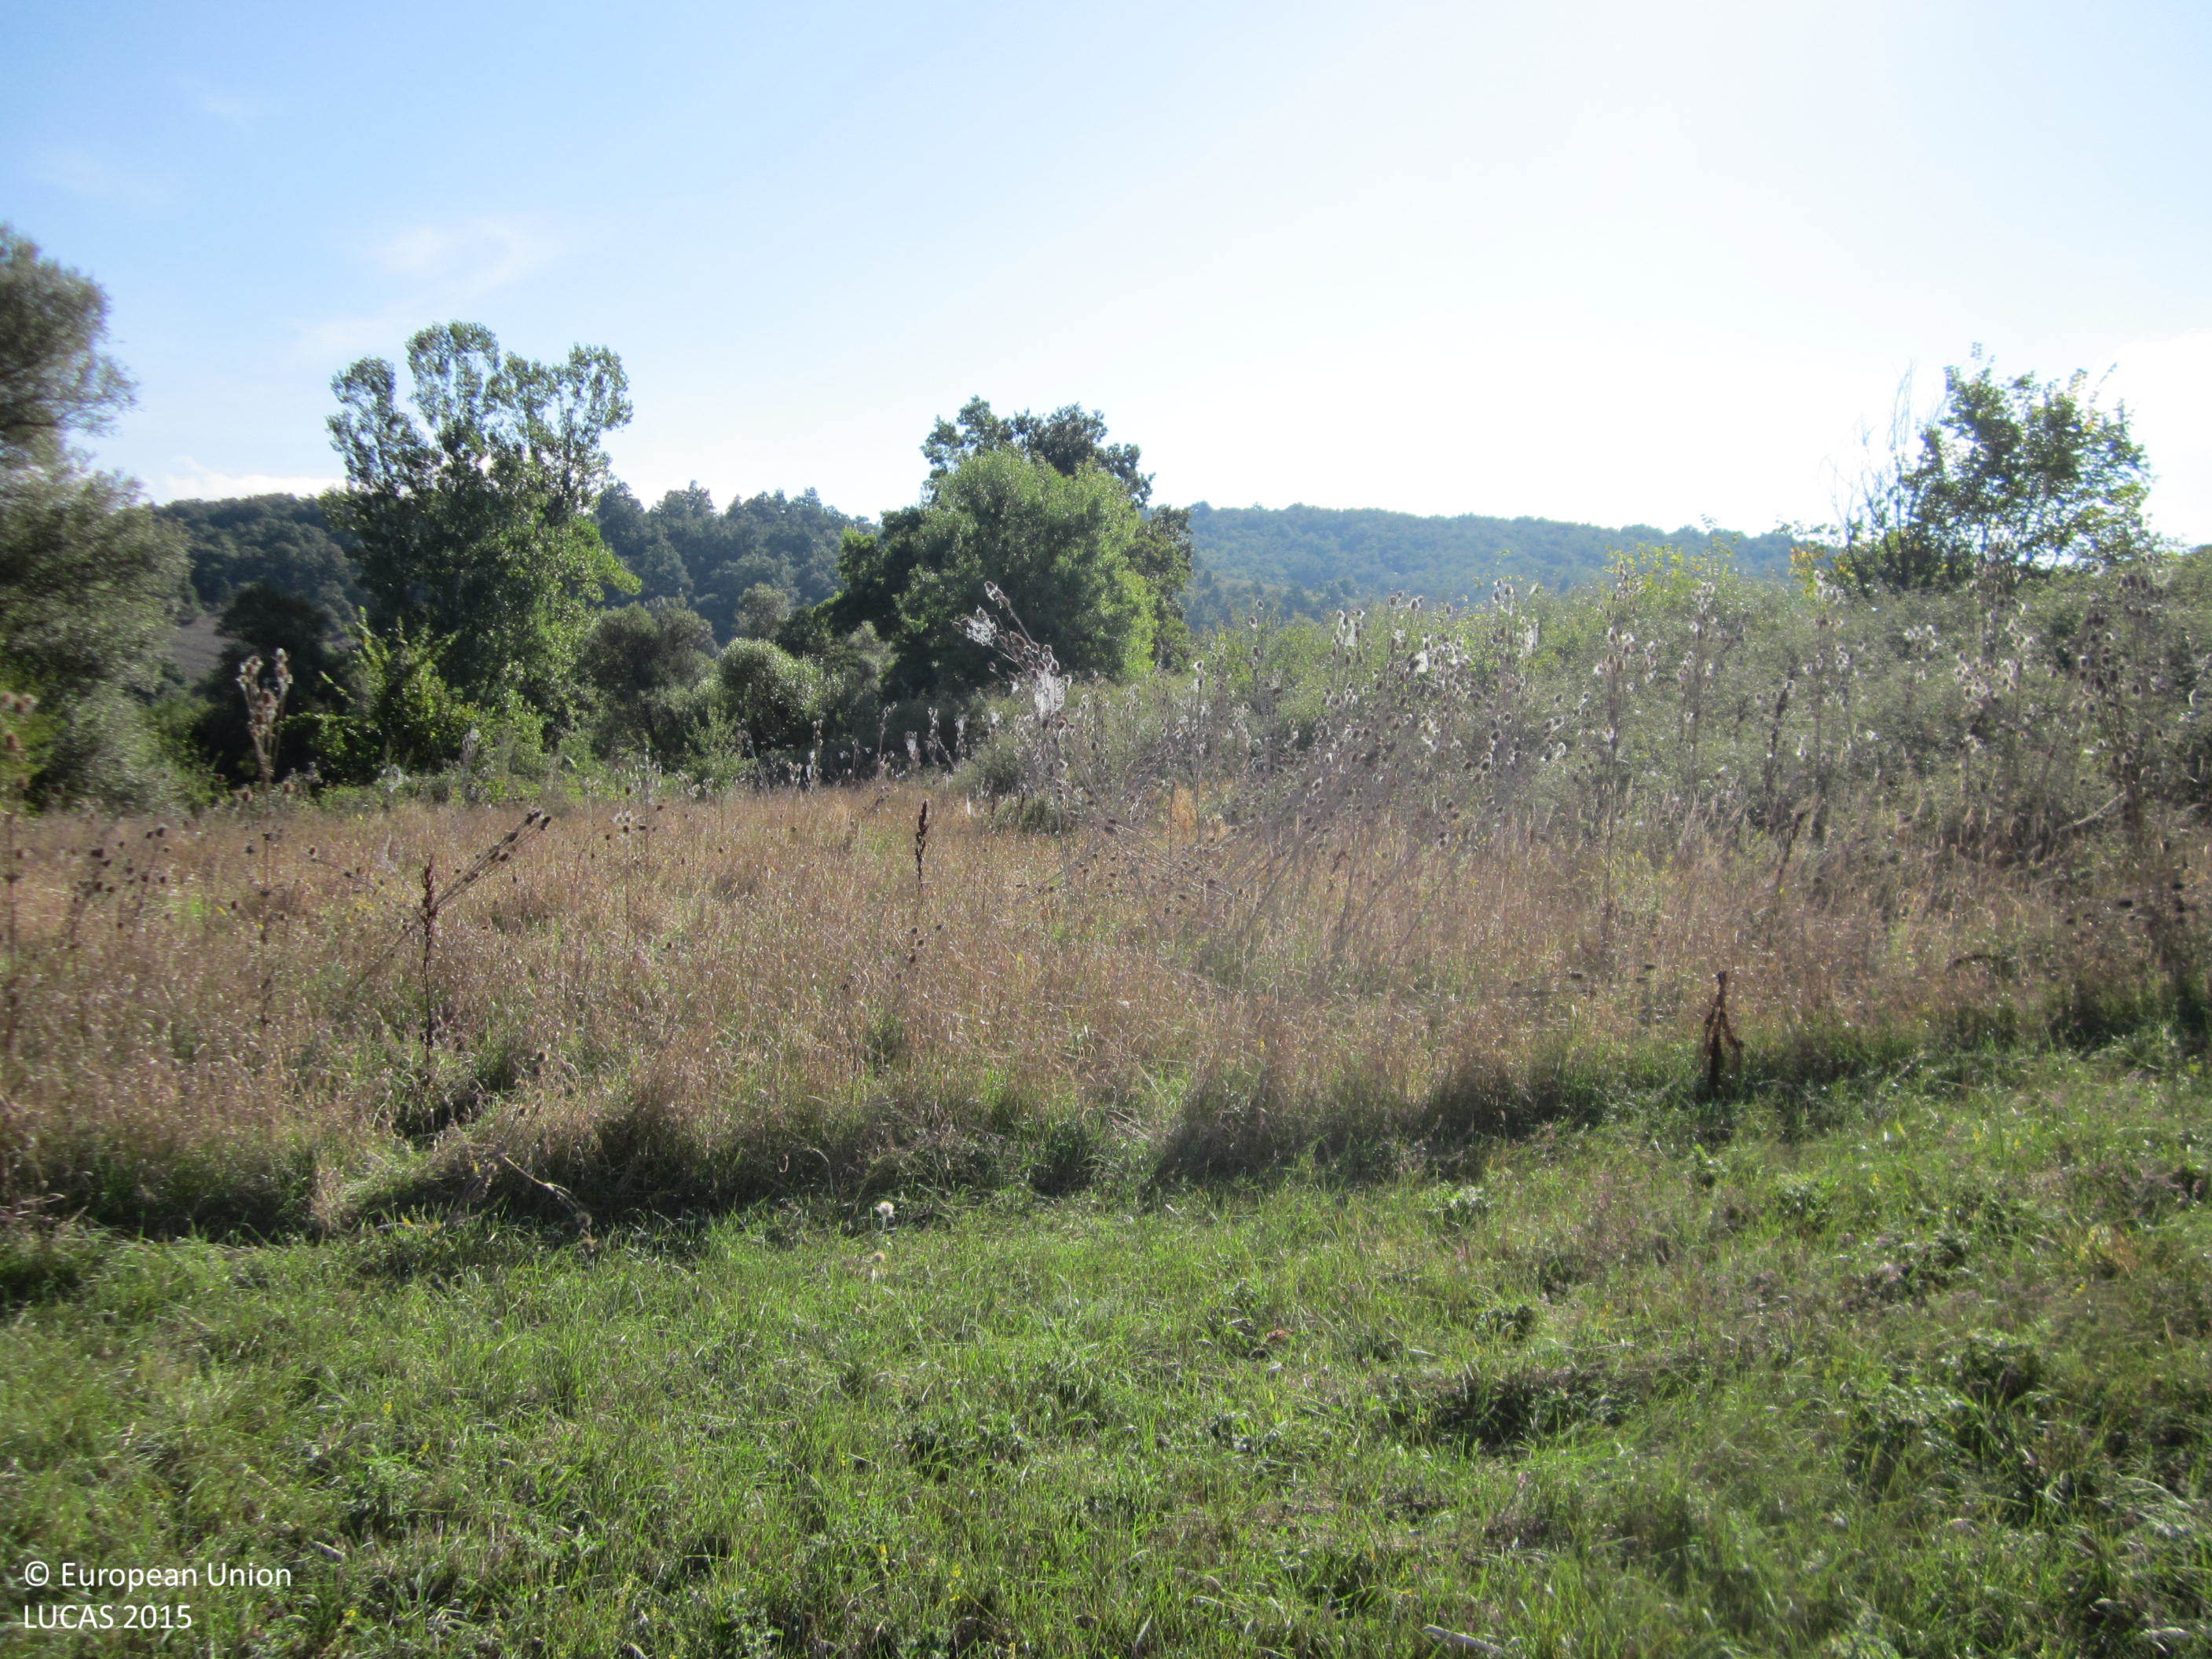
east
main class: Grassland
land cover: Grassland without tree/shrub cover
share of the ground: > 75 %
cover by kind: herbaceous plants 100 %
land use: Agriculture (excluding fallow land and kitchen gardens)
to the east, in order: Grassland without tree/shrub cover; Broadleaved woodland; Tracks; Broadleaved woodland; Inland fresh water bodies; Shrubland with sparse tree cover; Broadleaved woodland
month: September
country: BG
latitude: 42.1794
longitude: 27.1133
